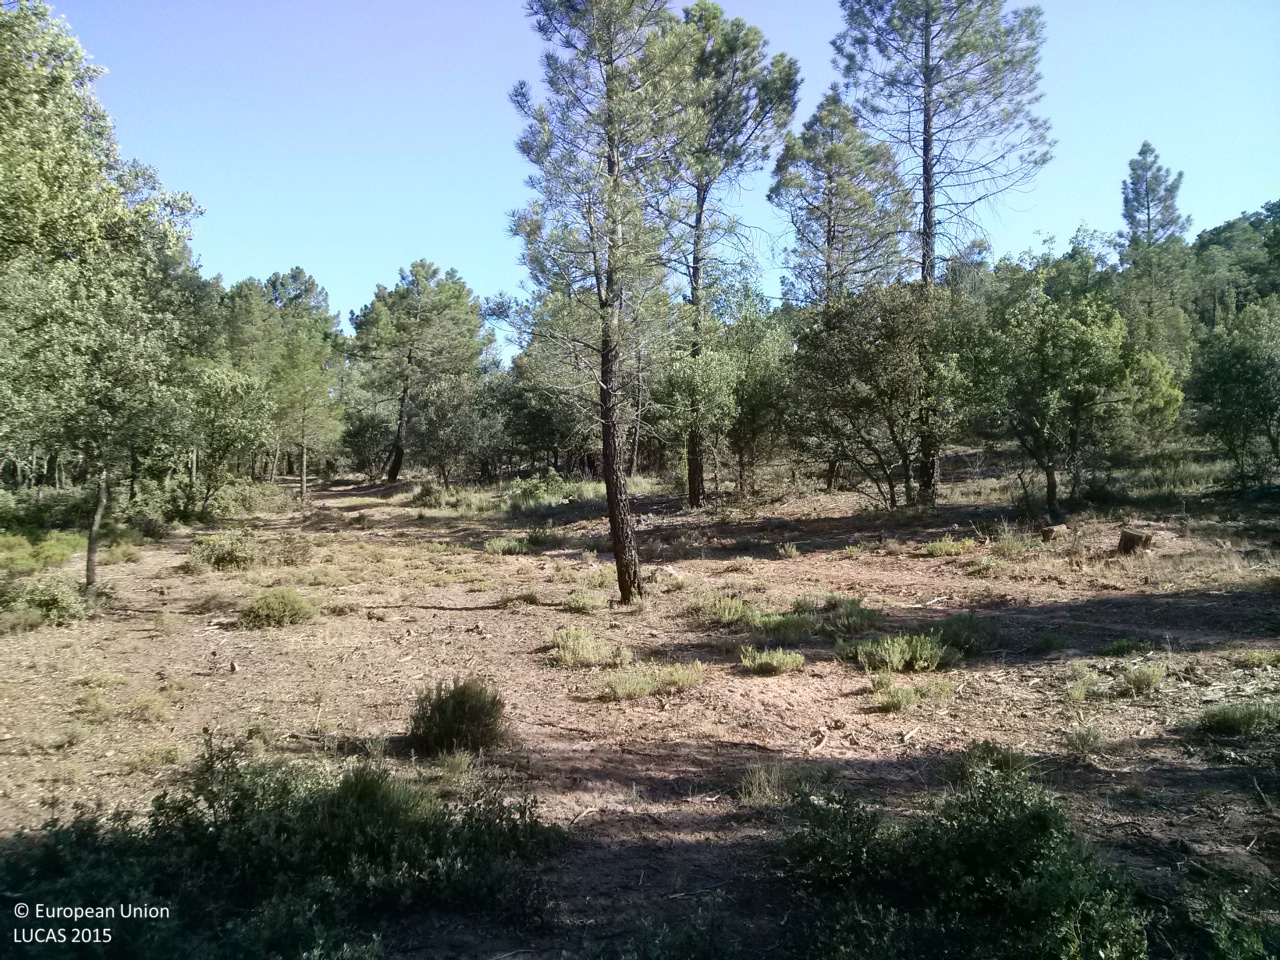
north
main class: Woodland
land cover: Other mixed woodland
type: broadleaved evergreen forest
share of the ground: 10 - 25 %
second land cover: Shrubland without tree cover
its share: 10 - 25 %
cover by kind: shrubs 25 %, herbaceous plants 25 %, unconsolidated bare surface 25 %, broadleaved forest trees 15 %, coniferous forest trees 10 %
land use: Forestry
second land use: Agriculture (excluding fallow land and kitchen gardens)
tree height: > 5 m
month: June
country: ES
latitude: 39.9506
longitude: -1.6803
